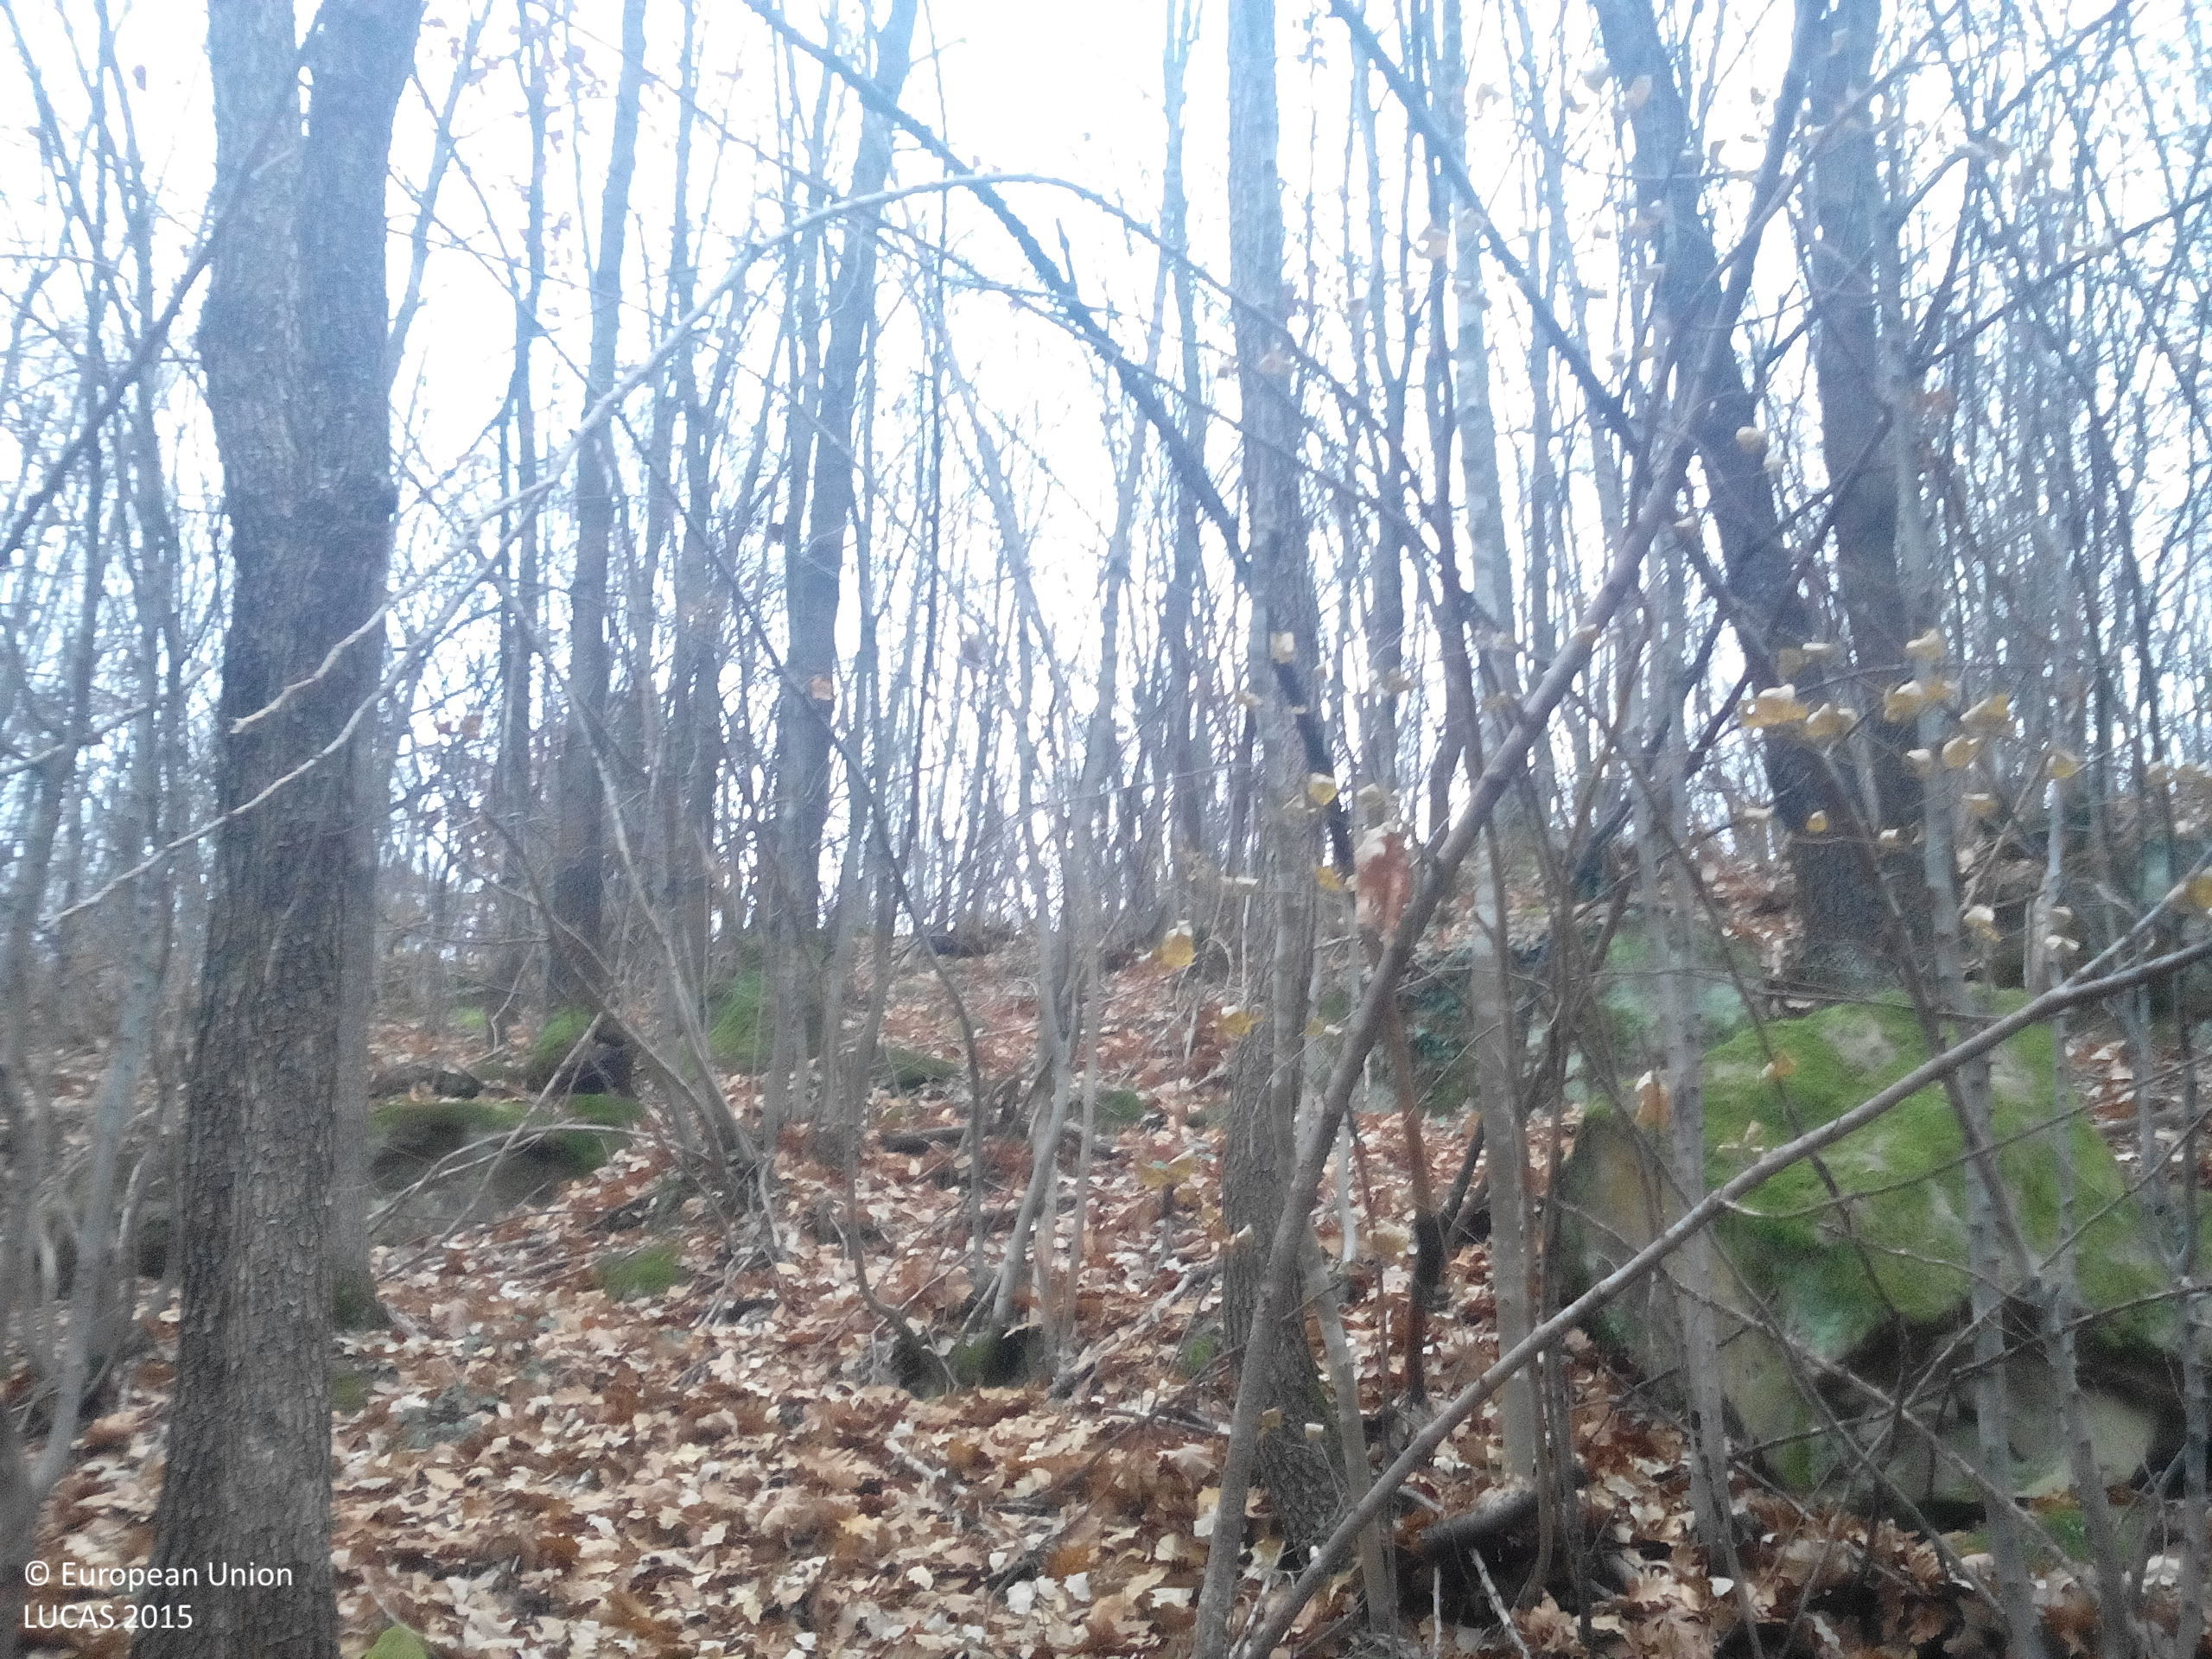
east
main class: Woodland
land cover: Broadleaved woodland
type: mesophytic deciduous forest
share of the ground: > 75 %
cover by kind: broadleaved forest trees 100 %
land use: Forestry
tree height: > 5 m
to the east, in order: Broadleaved woodland; Tracks; Grass margins; Tracks; Grassland with sparse tree/shrub cover; Broadleaved woodland; Shrubland with sparse tree cover; Broadleaved woodland; Grassland without tree/shrub cover; Abandoned hedges; Grassland without tree/shrub cover; Spontaneously vegetated surfaces
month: November
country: BG
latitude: 43.0809
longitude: 23.7647
